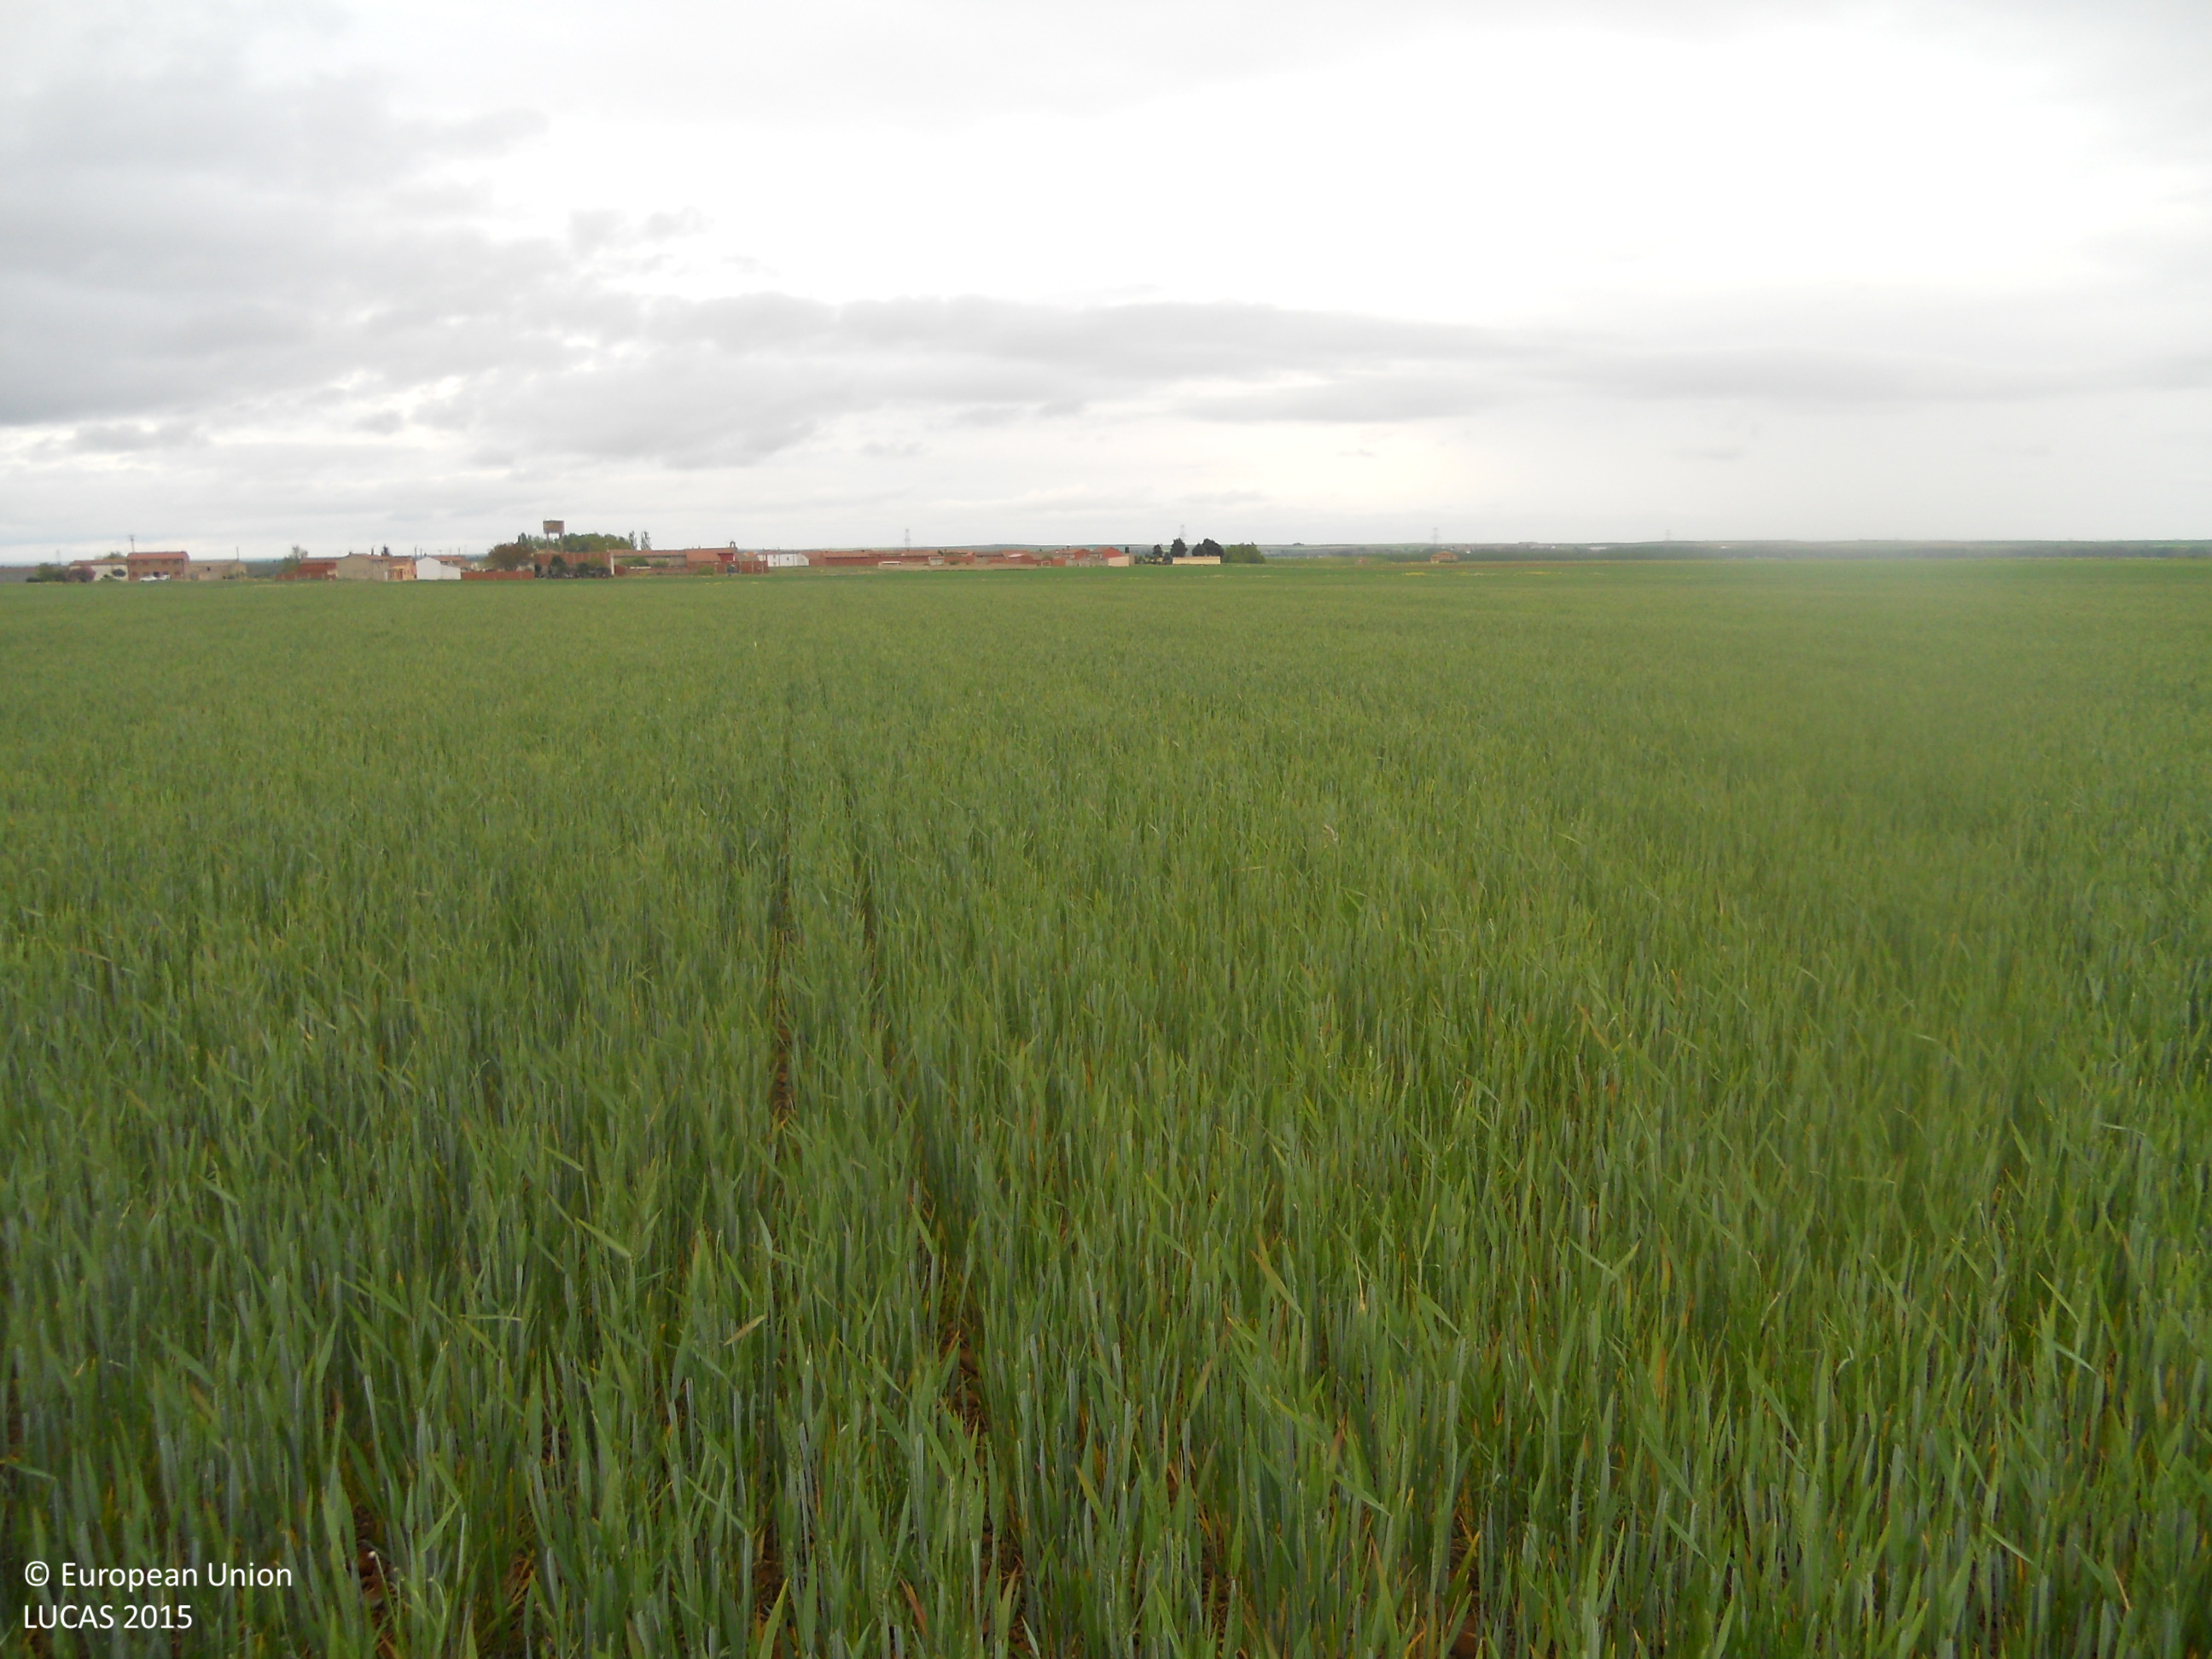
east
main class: Cropland
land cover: Common wheat
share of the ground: > 75 %
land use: Agriculture (excluding fallow land and kitchen gardens)
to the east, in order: Common wheat
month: May
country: ES
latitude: 42.2227
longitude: -5.2666
